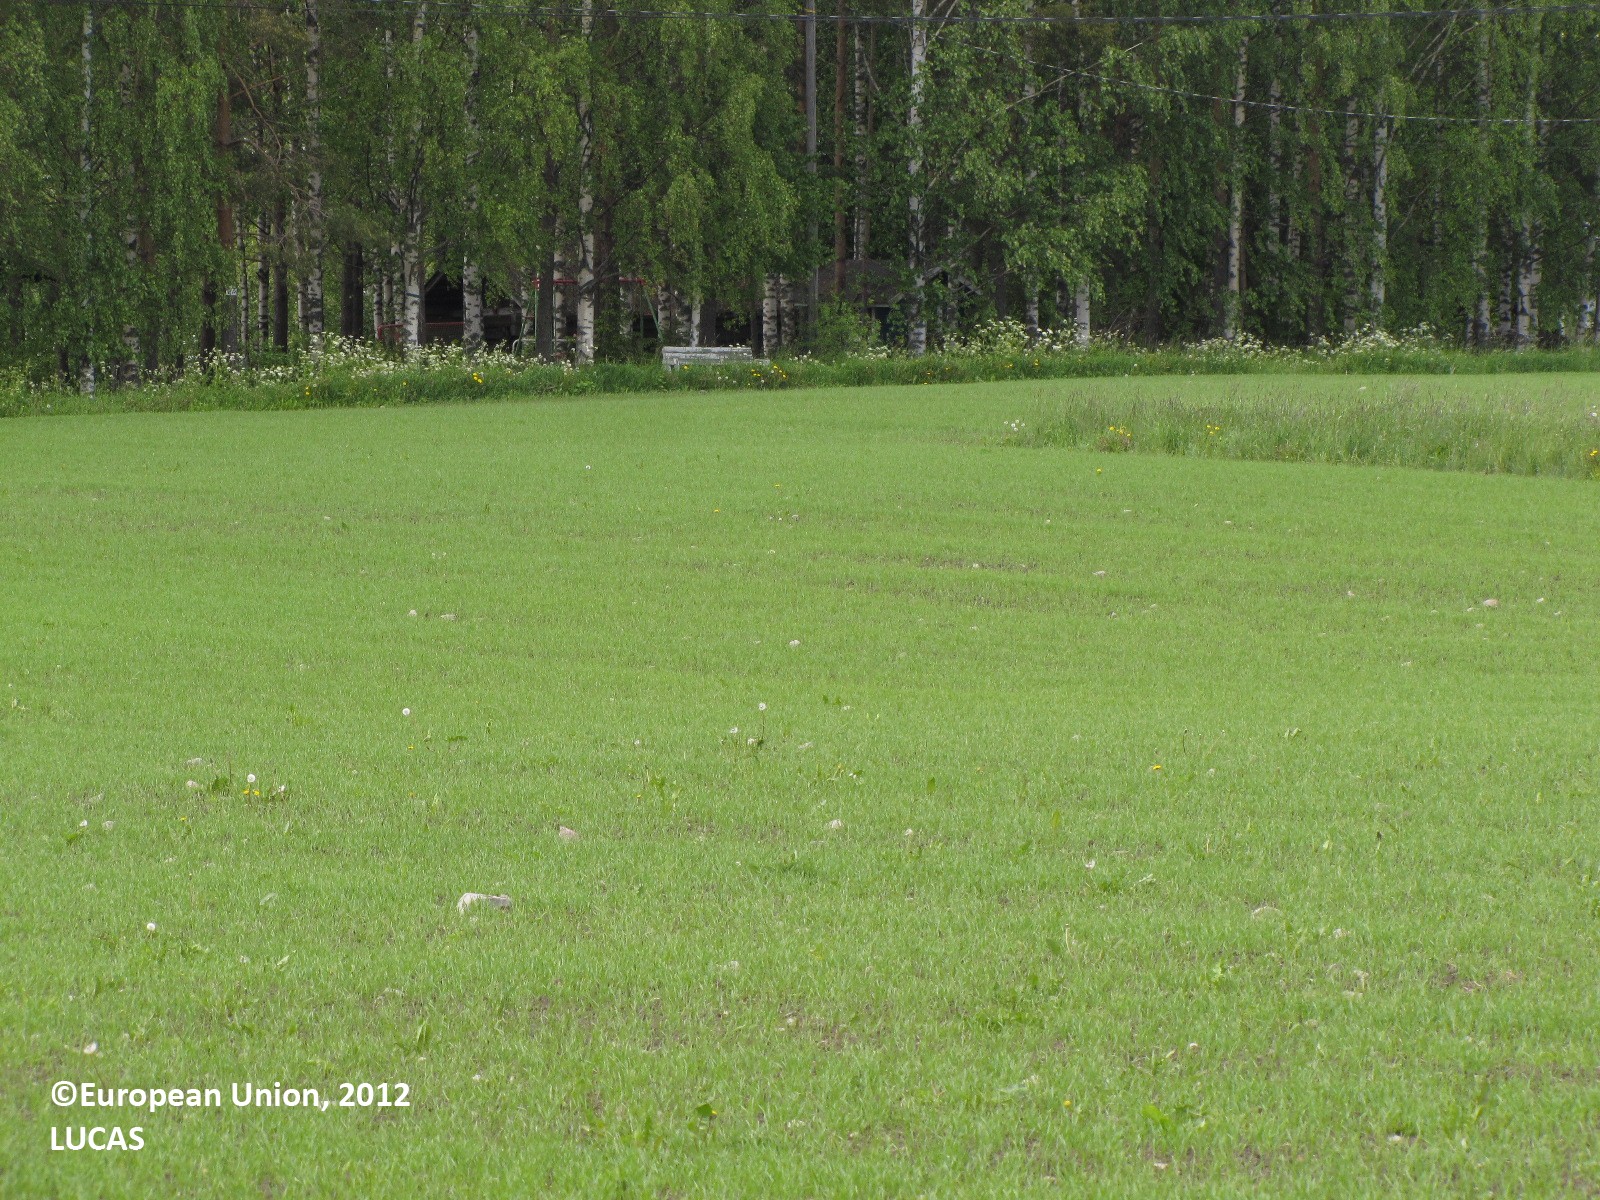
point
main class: Cropland
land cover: Common wheat
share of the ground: 50 - 75 %
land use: Agriculture (excluding fallow land and kitchen gardens)
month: June
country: FI
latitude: 61.4357
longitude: 23.0649
